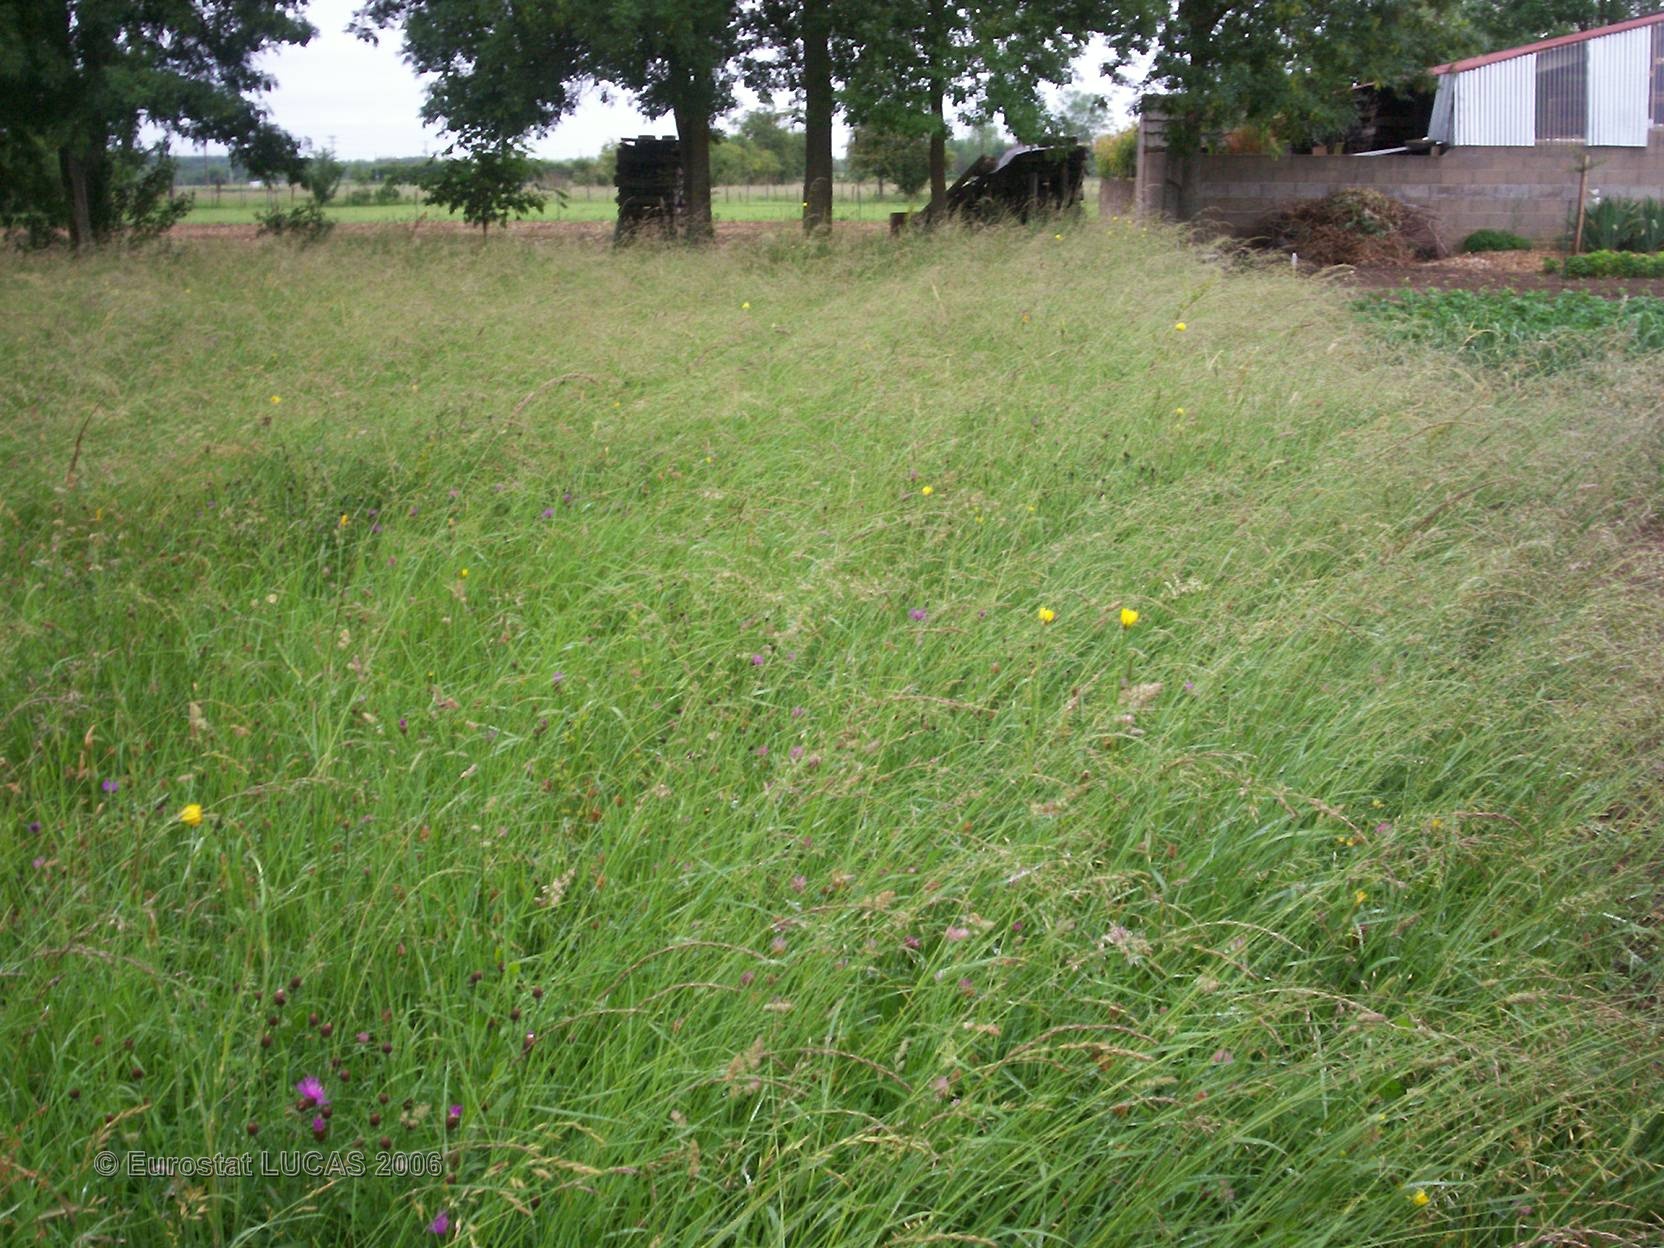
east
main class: Cropland
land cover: Other fresh vegetables
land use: Kitchen garden
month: May
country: FR
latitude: 46.7202
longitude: 0.4436
